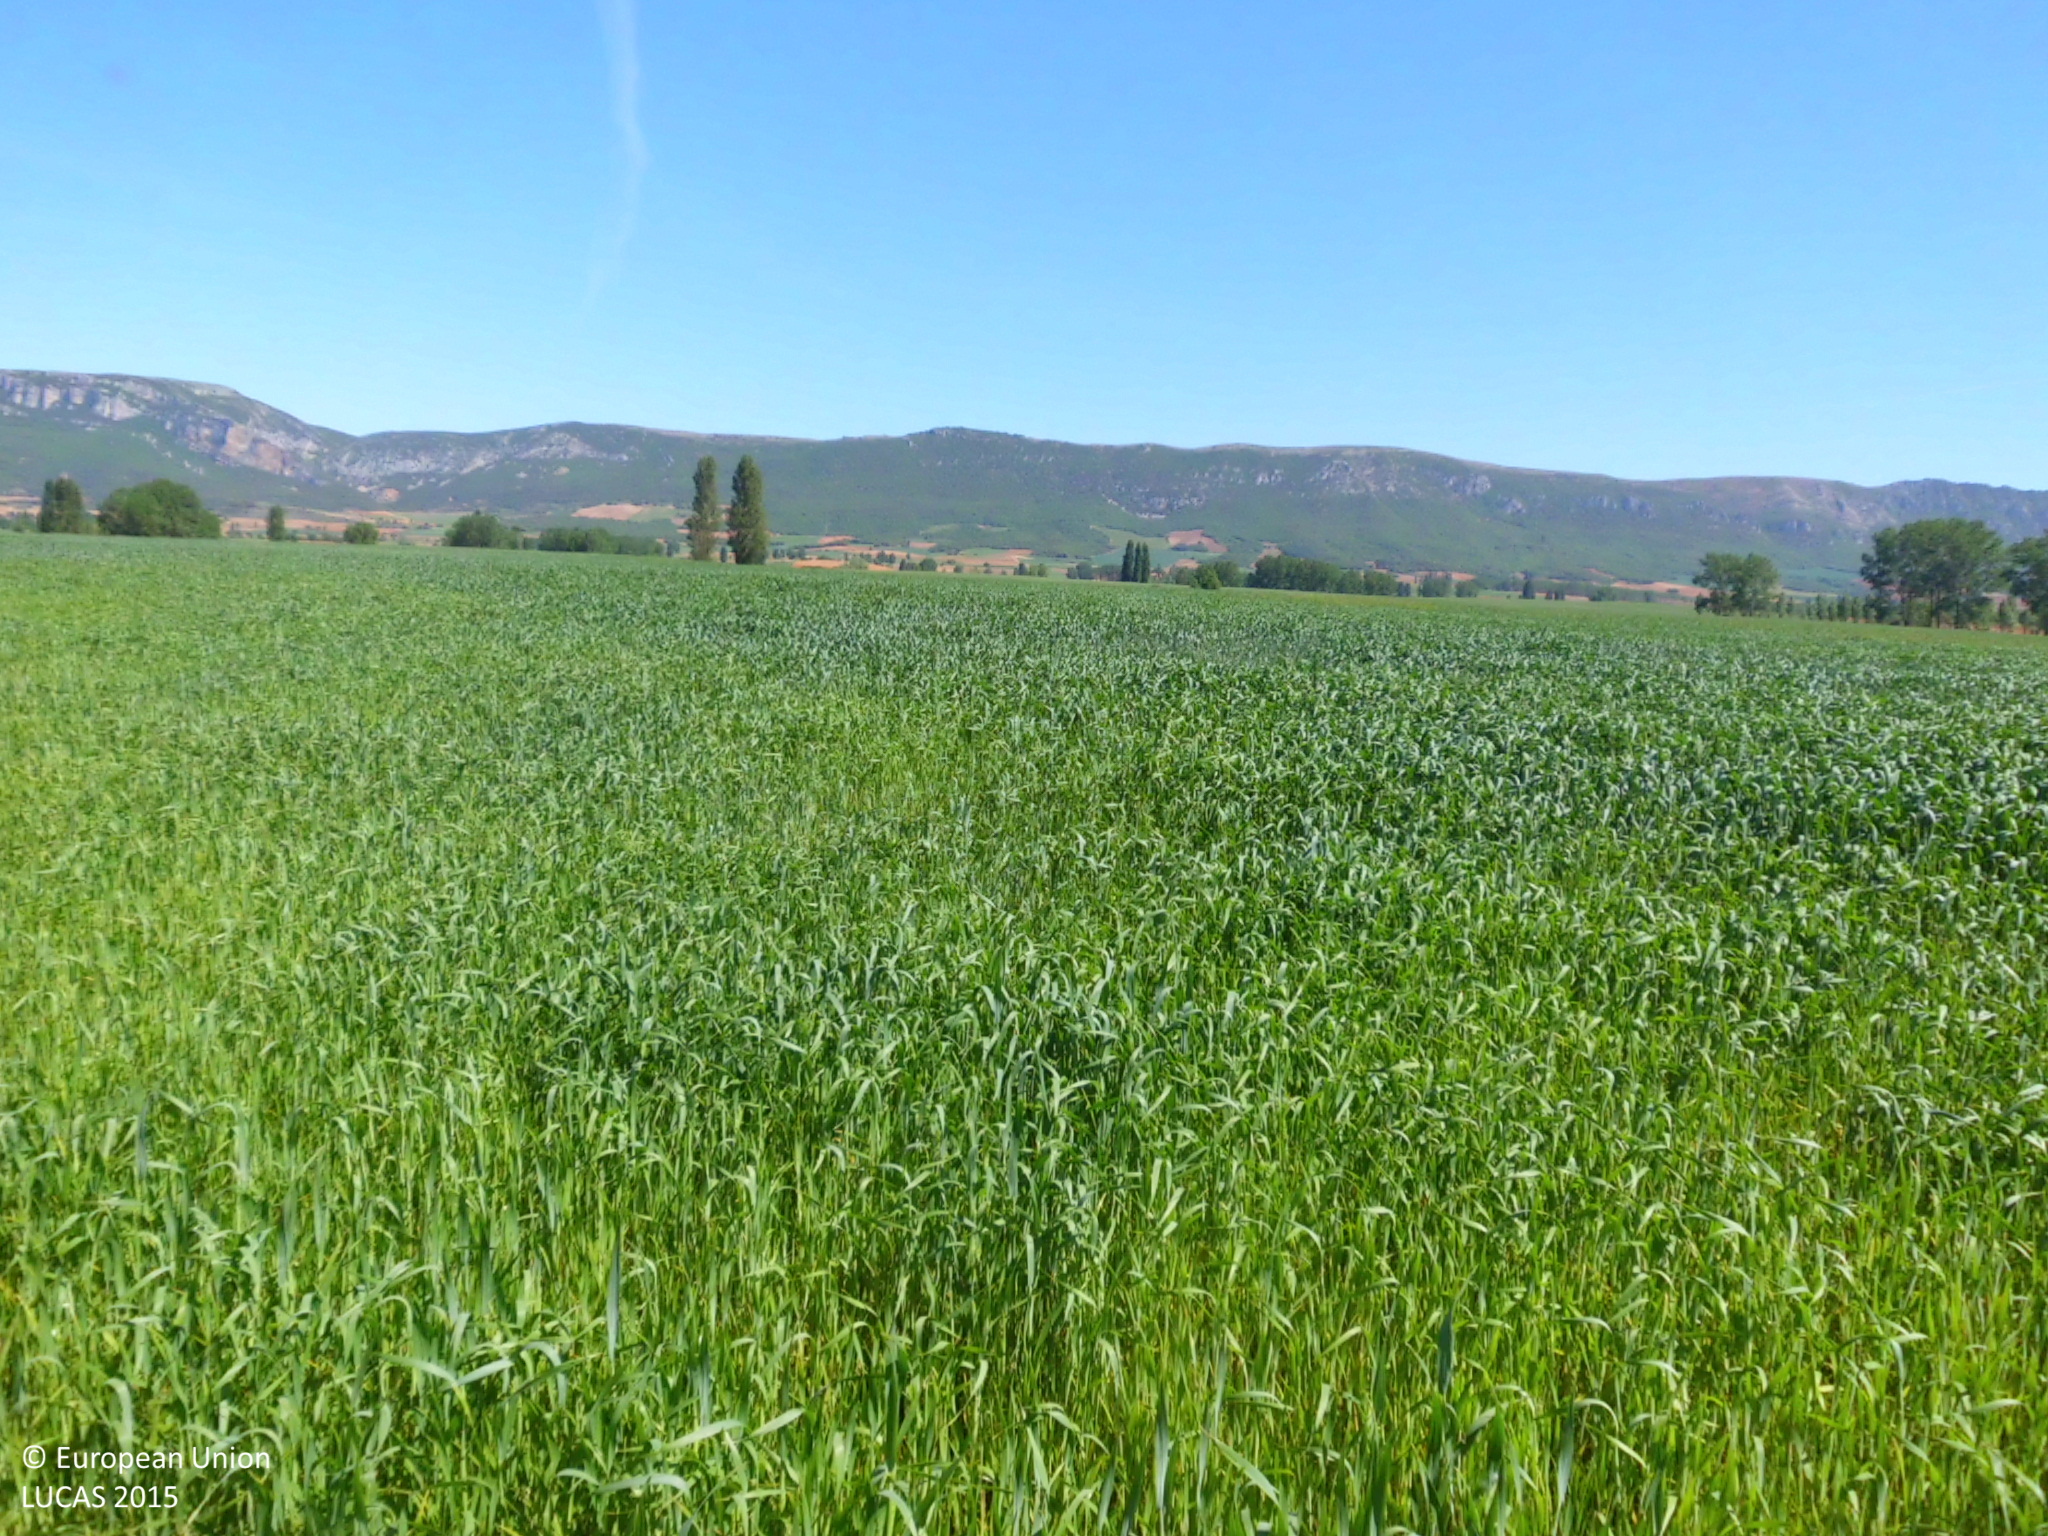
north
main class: Cropland
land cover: Common wheat
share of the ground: 50 - 75 %
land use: Agriculture (excluding fallow land and kitchen gardens)
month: May
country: ES
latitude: 42.6590
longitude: -3.3686
